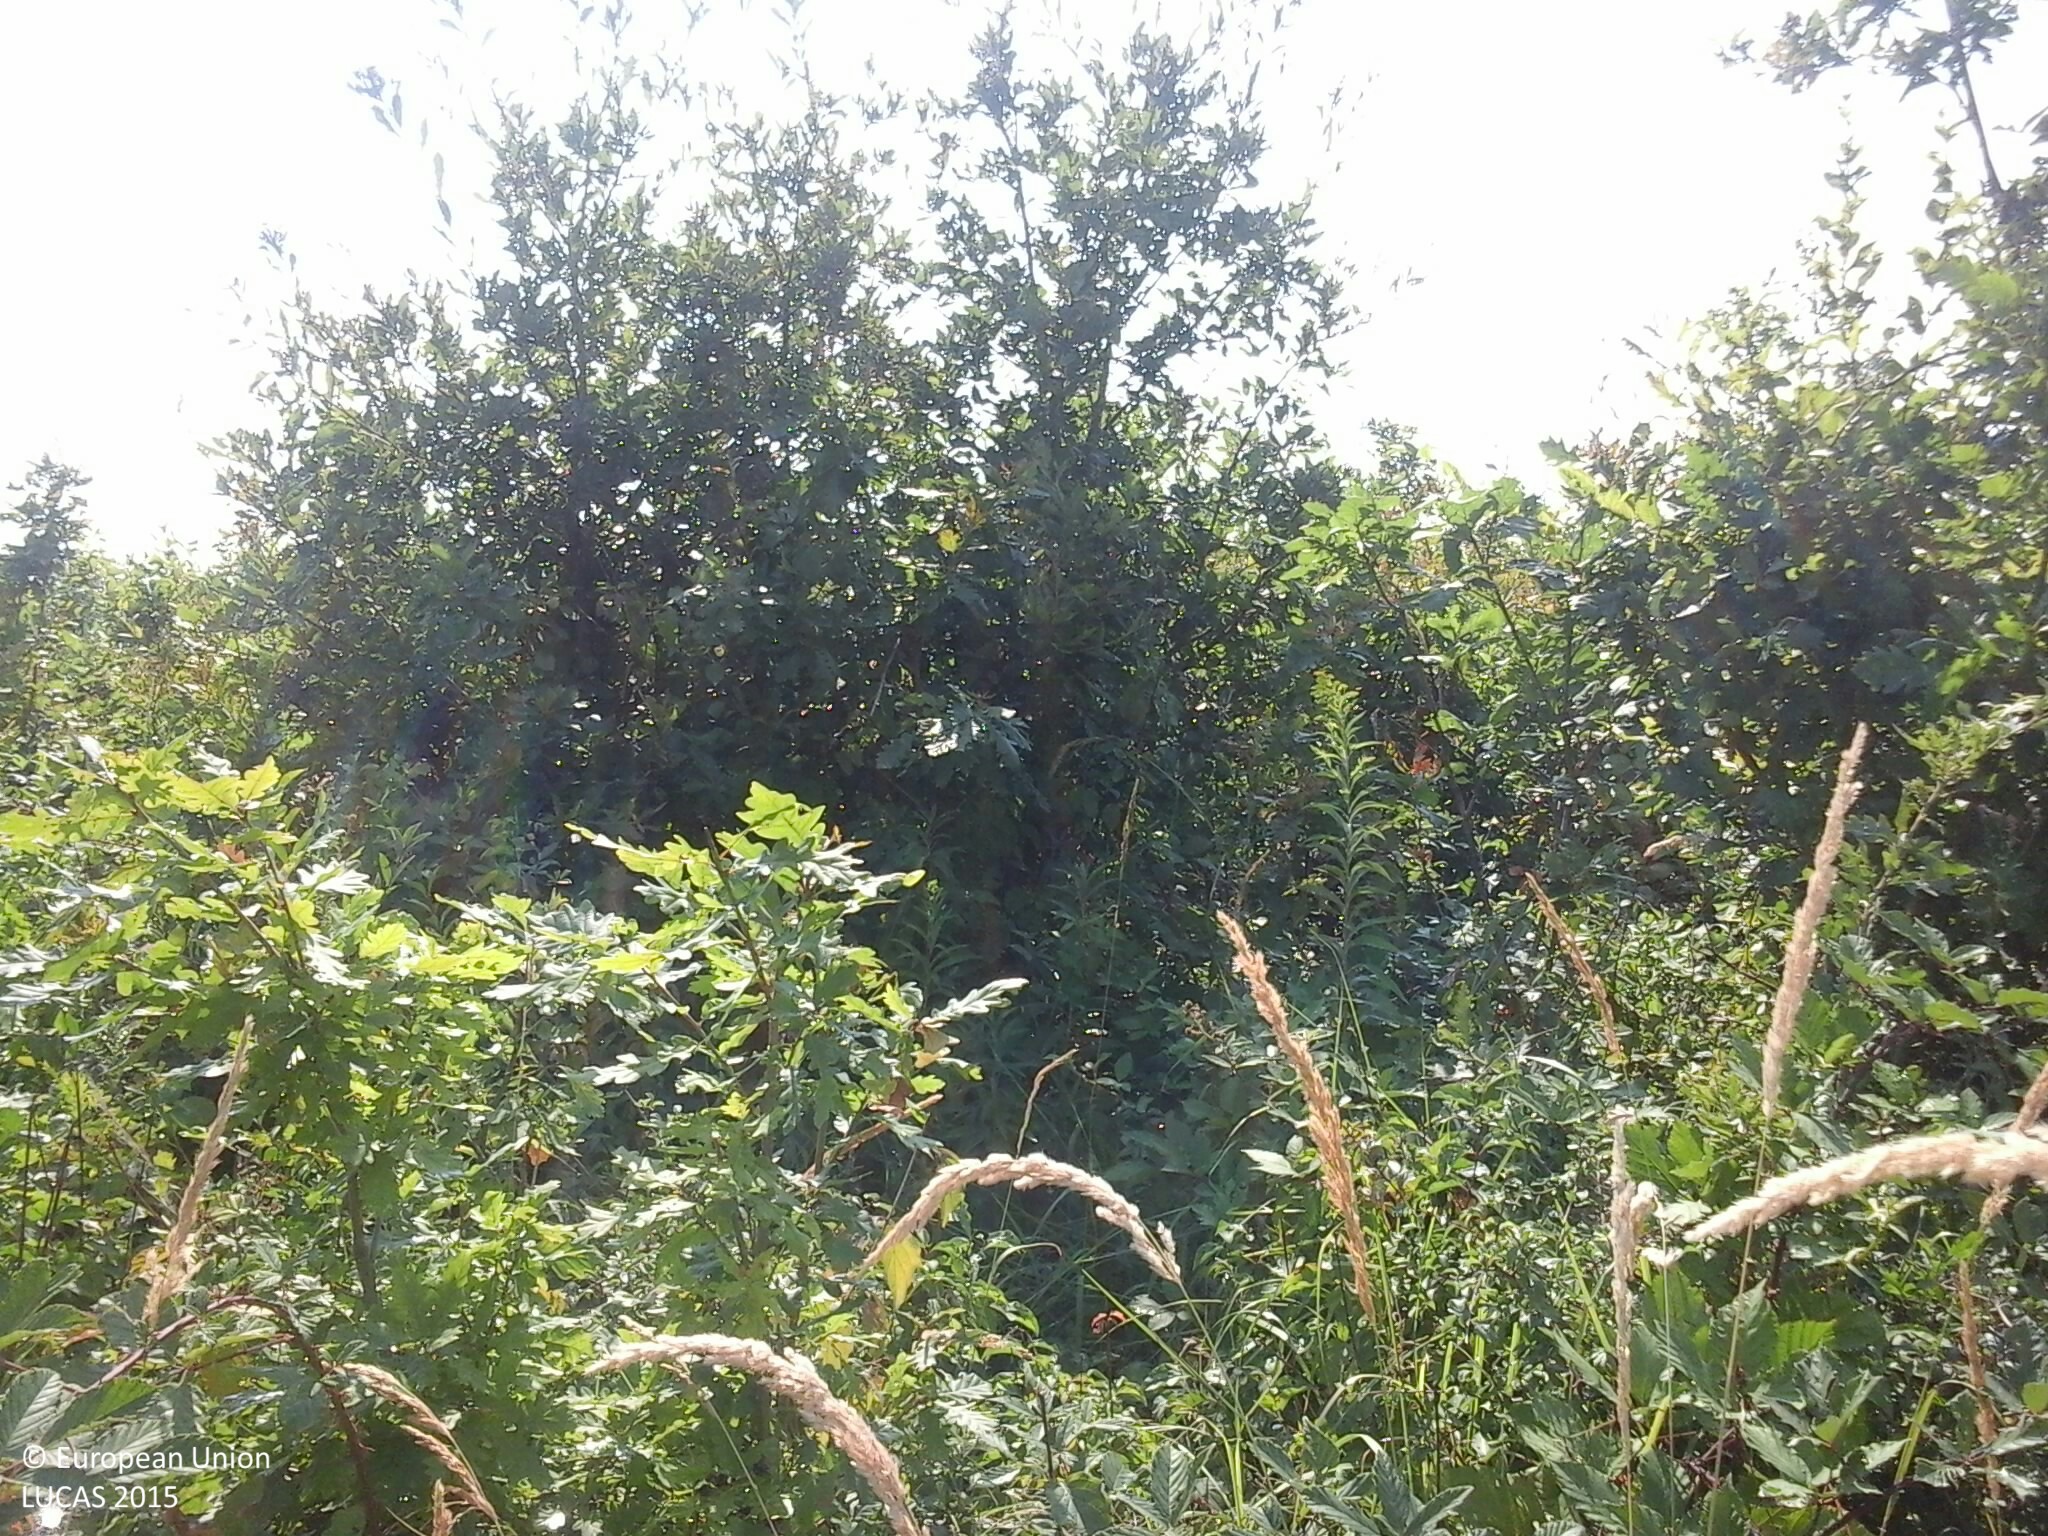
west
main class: Woodland
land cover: Broadleaved woodland
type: mesophytic deciduous forest
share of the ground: 50 - 75 %
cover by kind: broadleaved forest trees 50 %, herbaceous plants 30 %, shrubs 20 %
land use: Forestry
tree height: < 5 m
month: August
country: HU
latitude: 46.1384
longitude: 18.2794
